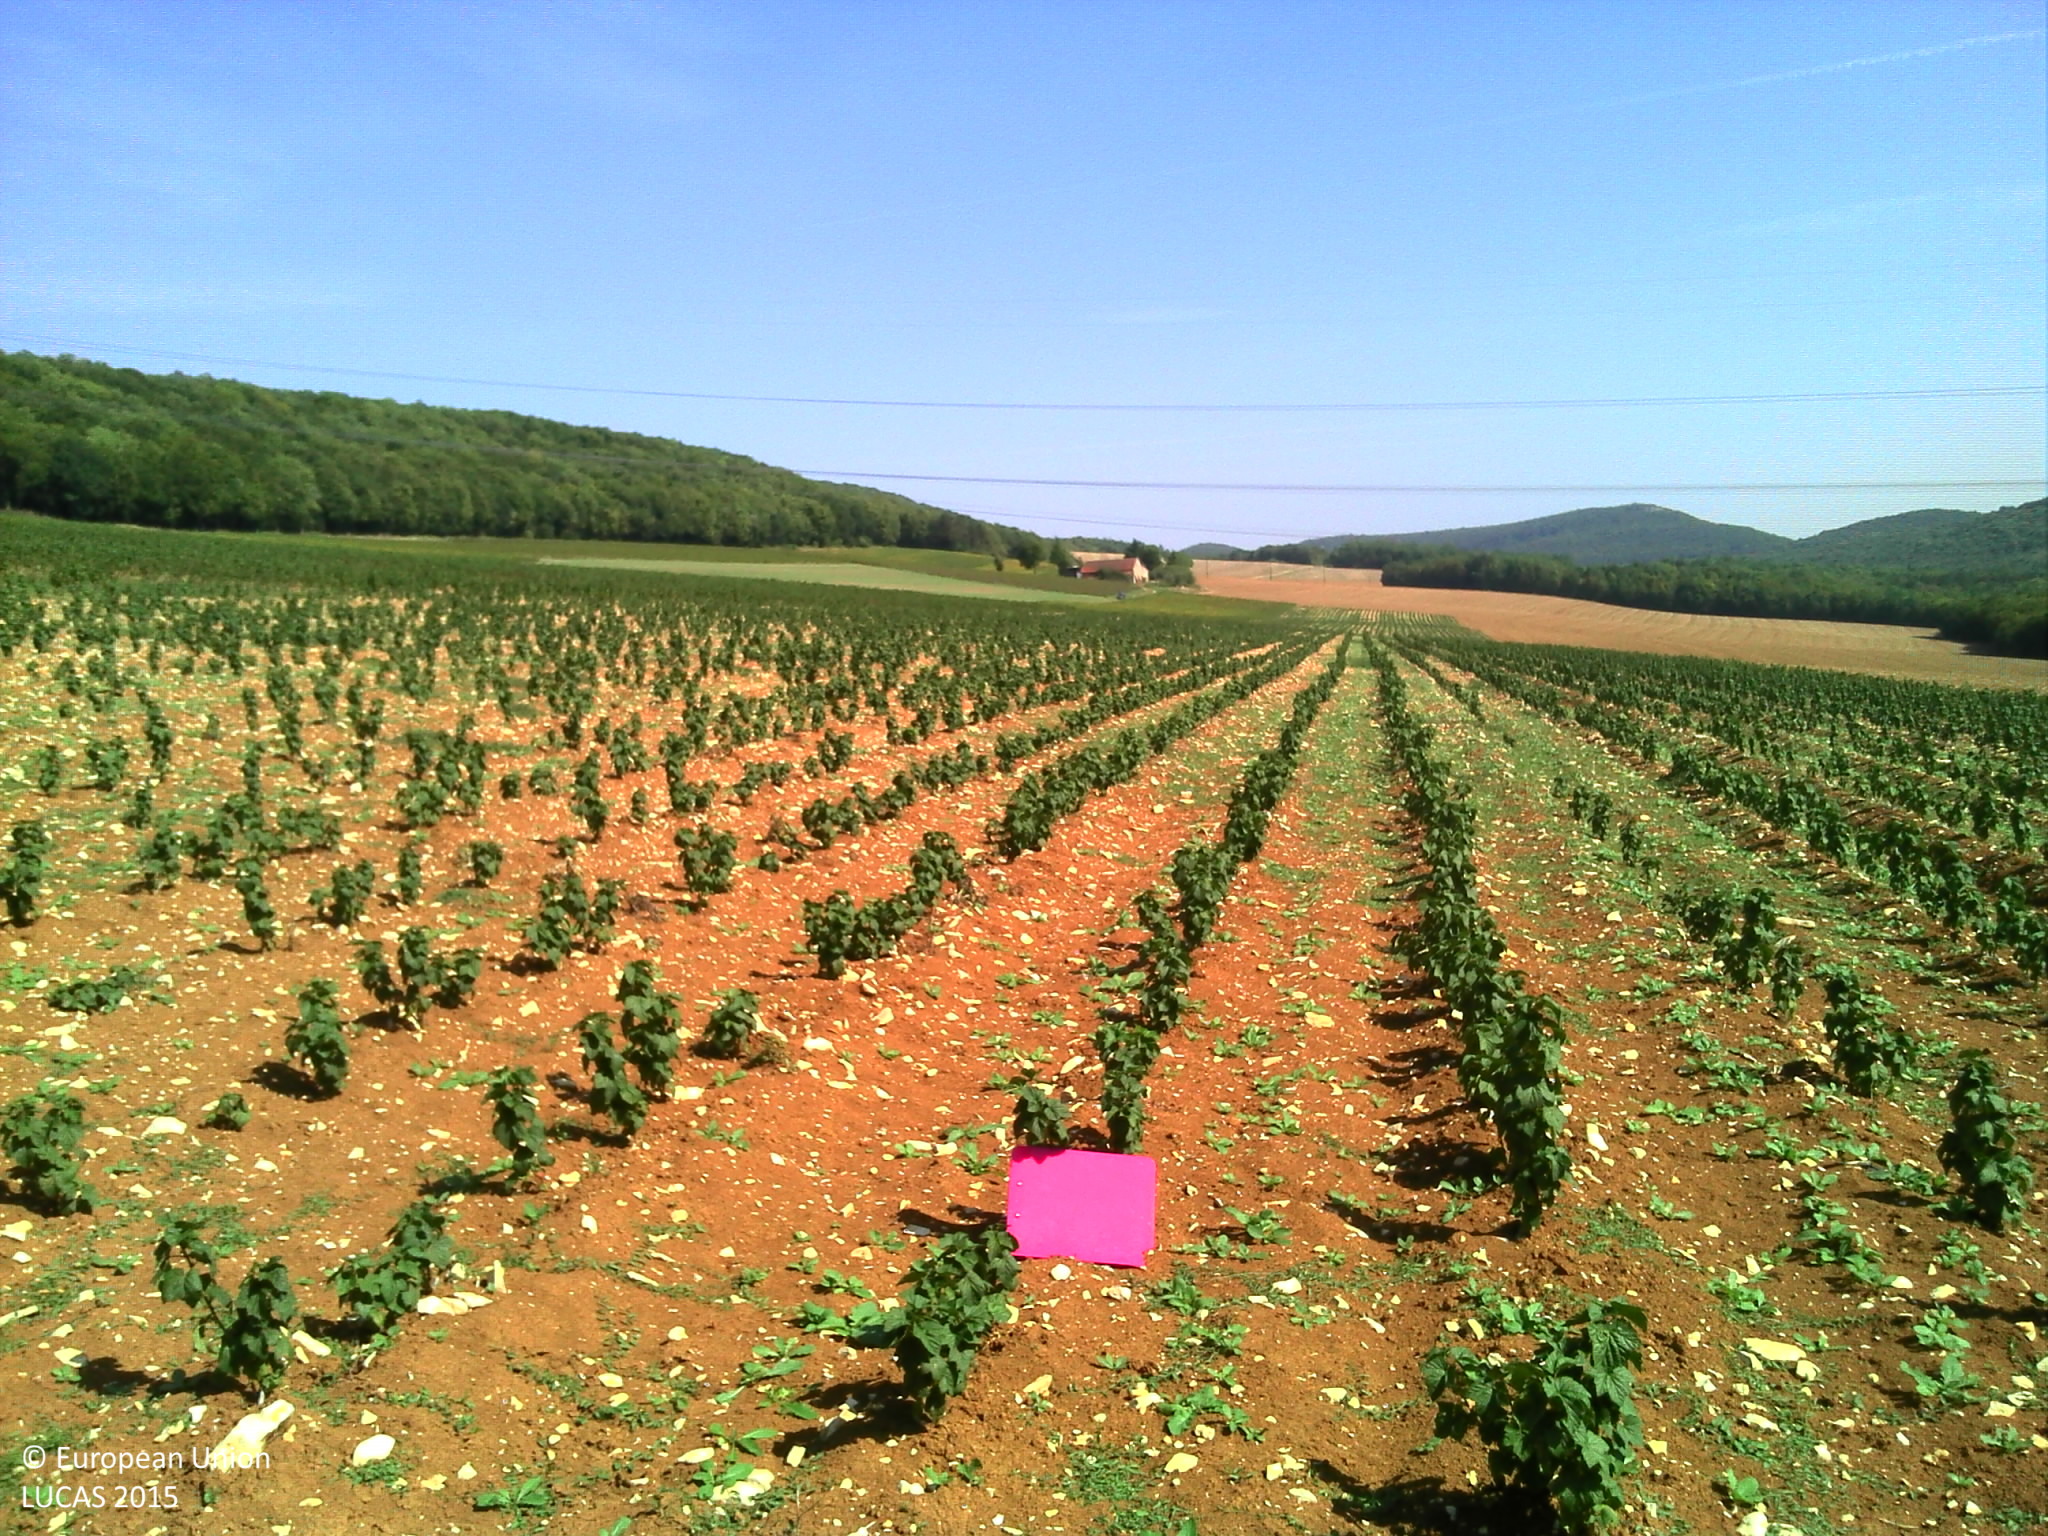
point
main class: Cropland
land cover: Other non-permanent industrial crops
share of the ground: 10 - 25 %
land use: Agriculture (excluding fallow land and kitchen gardens)
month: August
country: FR
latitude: 47.2536
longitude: 4.8073
